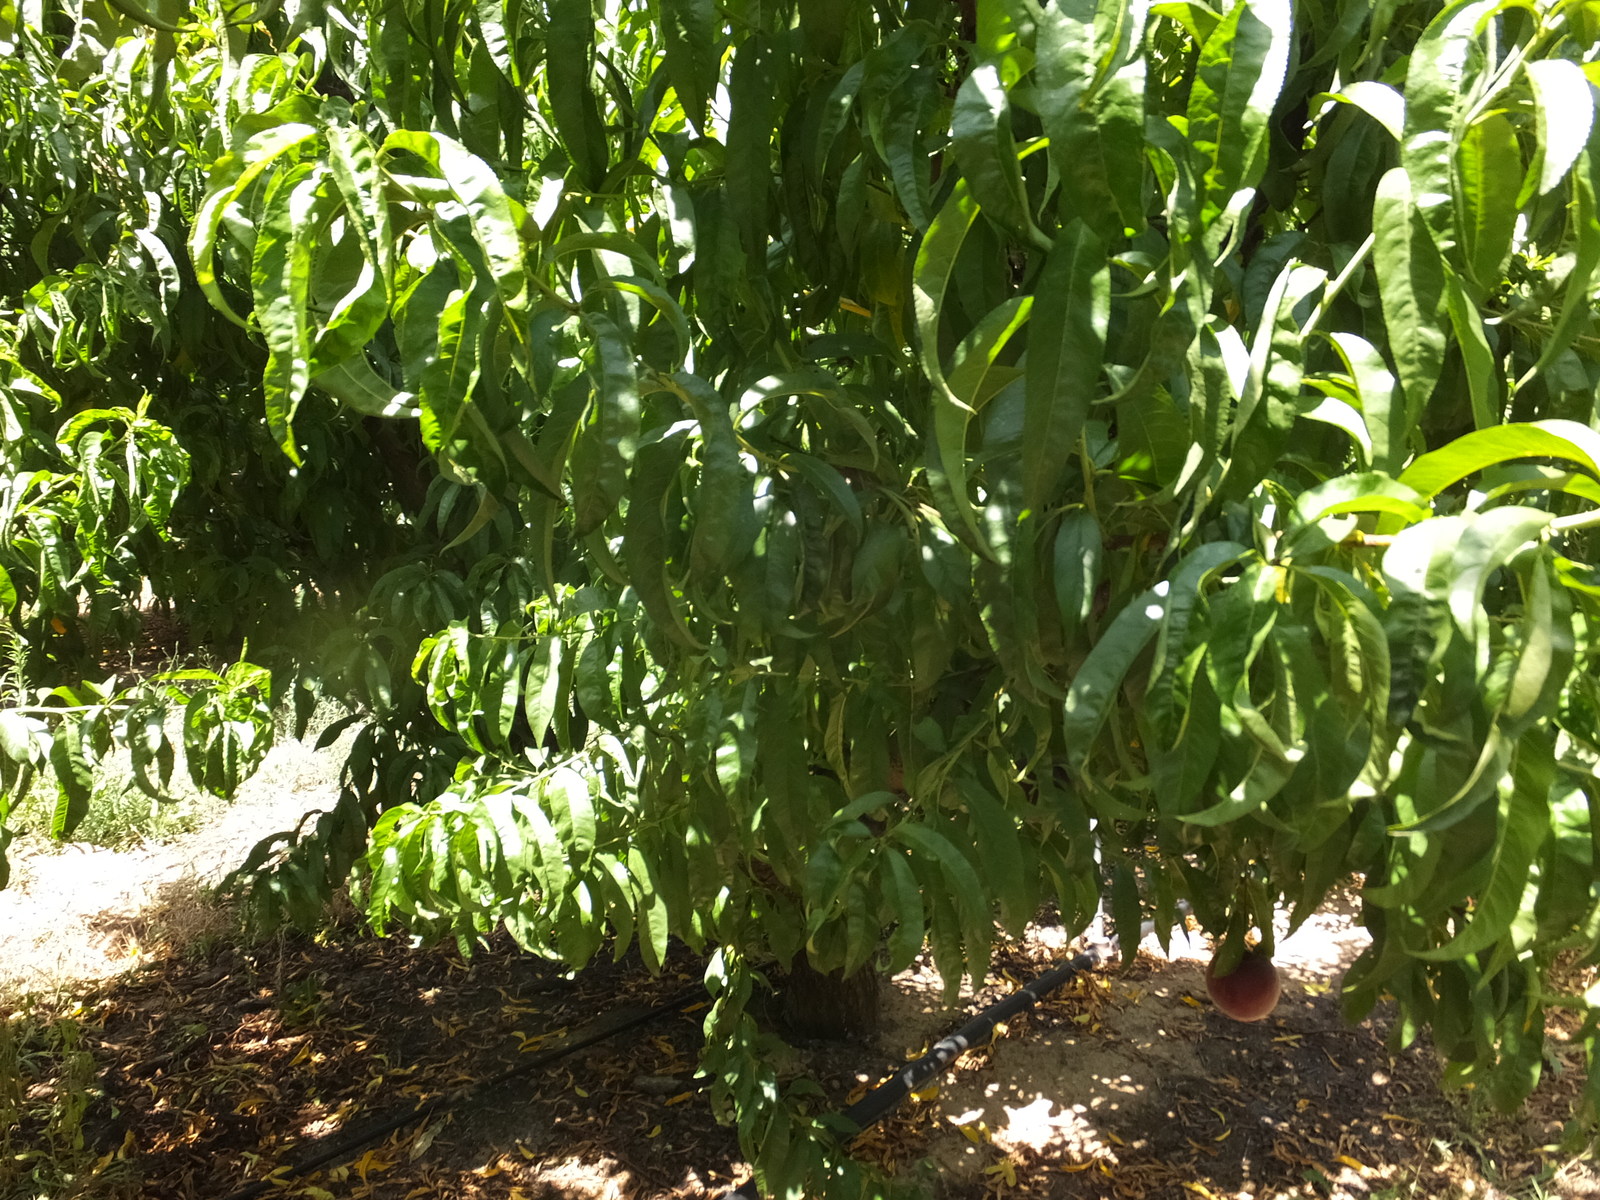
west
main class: Cropland
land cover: Other fruit trees and berries
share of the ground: 50 - 75 %
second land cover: Other bare soil
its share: > 75 %
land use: Agriculture (excluding fallow land and kitchen gardens)
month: July
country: ES
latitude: 41.4584
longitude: 0.4706
